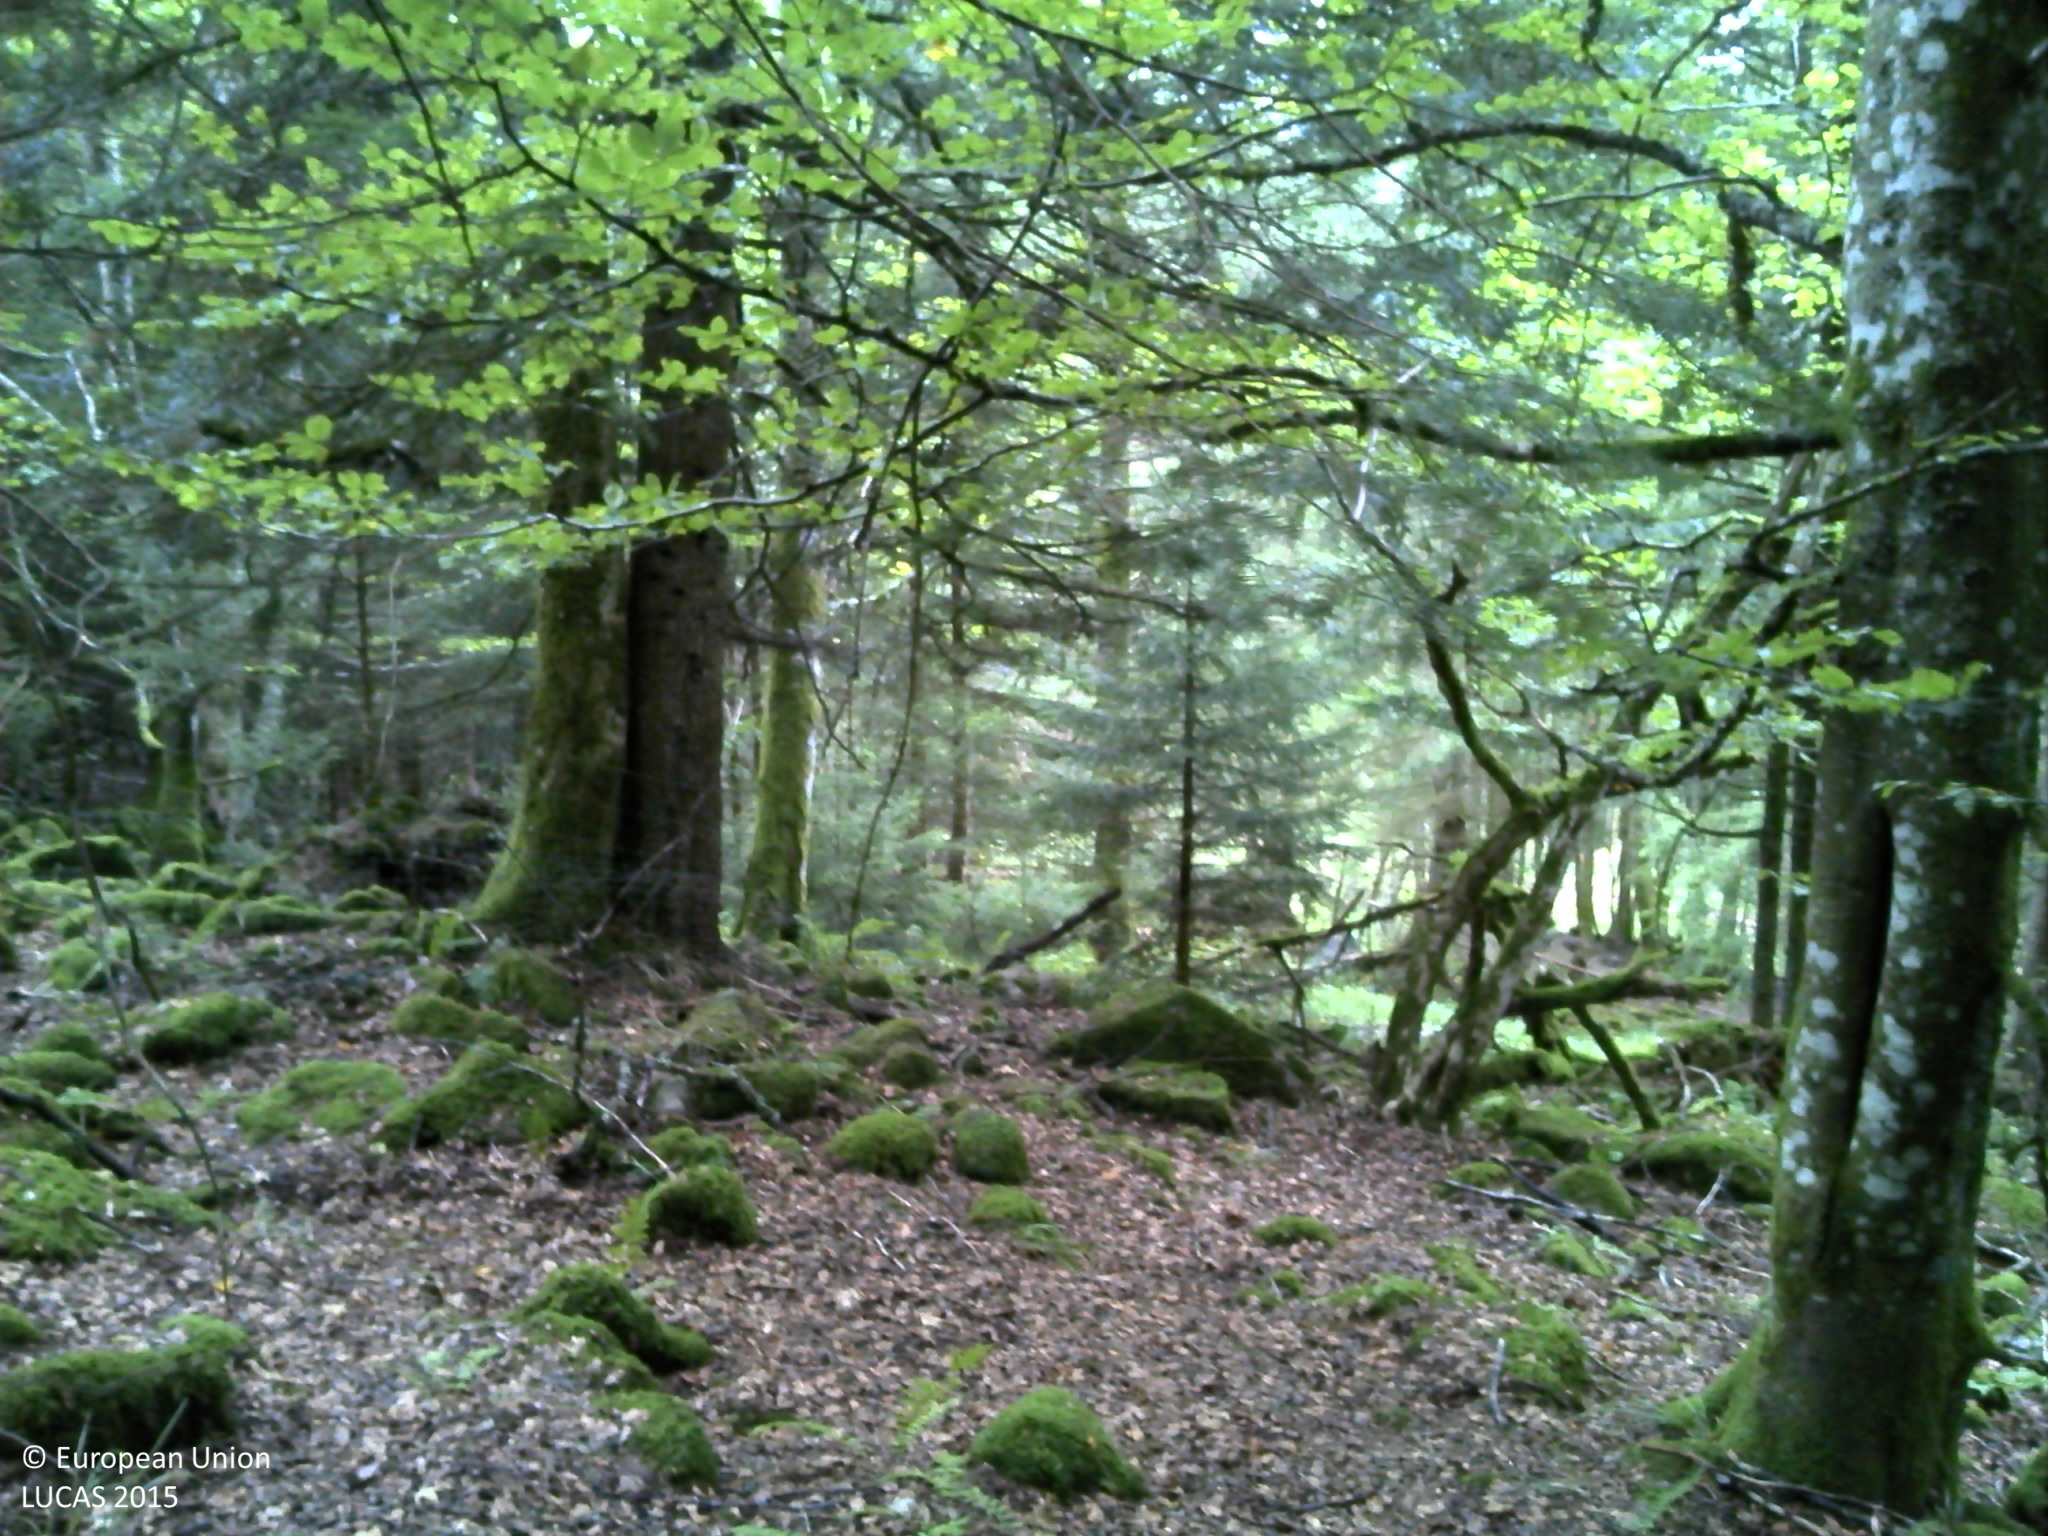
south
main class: Woodland
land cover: Spruce dominated mixed woodland
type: hemiboreal forest and nemoral coniferous forest and mixed broadleaved-coniferous forest
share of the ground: > 75 %
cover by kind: coniferous forest trees 50 %, broadleaved forest trees 30 %, consolidated bare surface 10 %, herbaceous plants 5 %, lichens and mosses 5 %
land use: Forestry
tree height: > 5 m
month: September
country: FR
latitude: 48.4242
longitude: 7.2846
